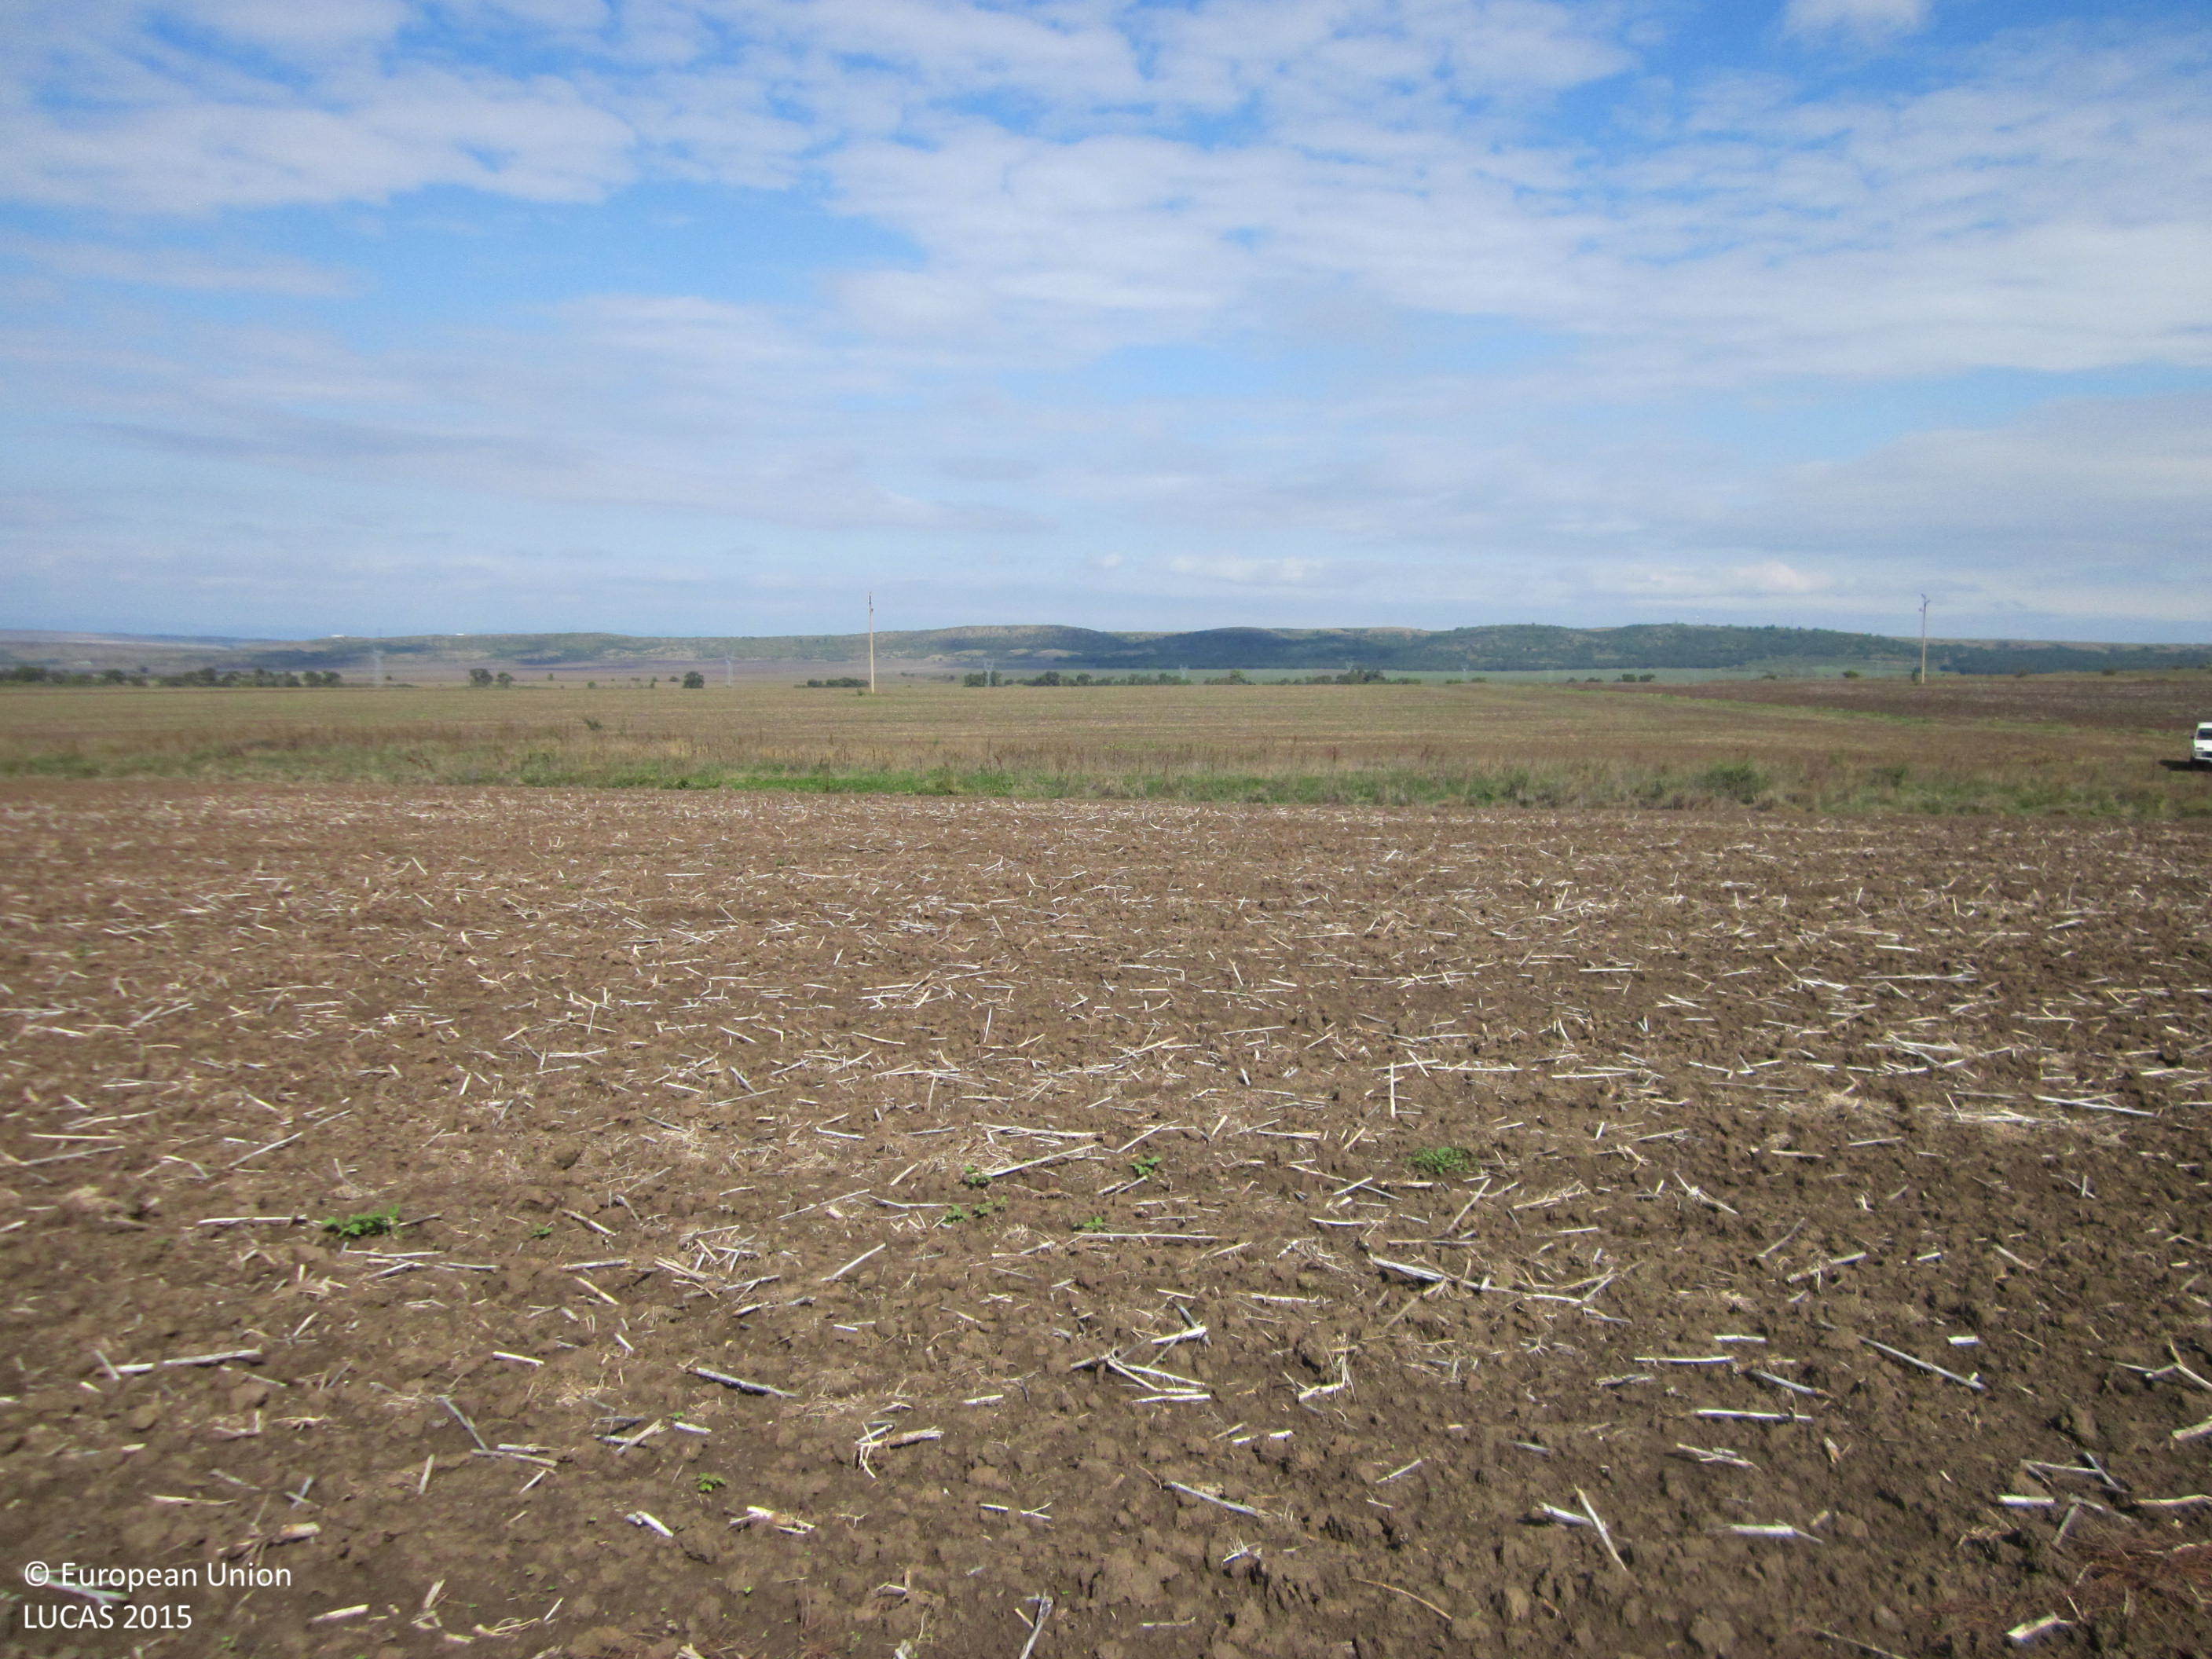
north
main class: Cropland
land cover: Sunflower
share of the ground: < 10 %
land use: Agriculture (excluding fallow land and kitchen gardens)
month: October
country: BG
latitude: 42.6006
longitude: 26.9111
